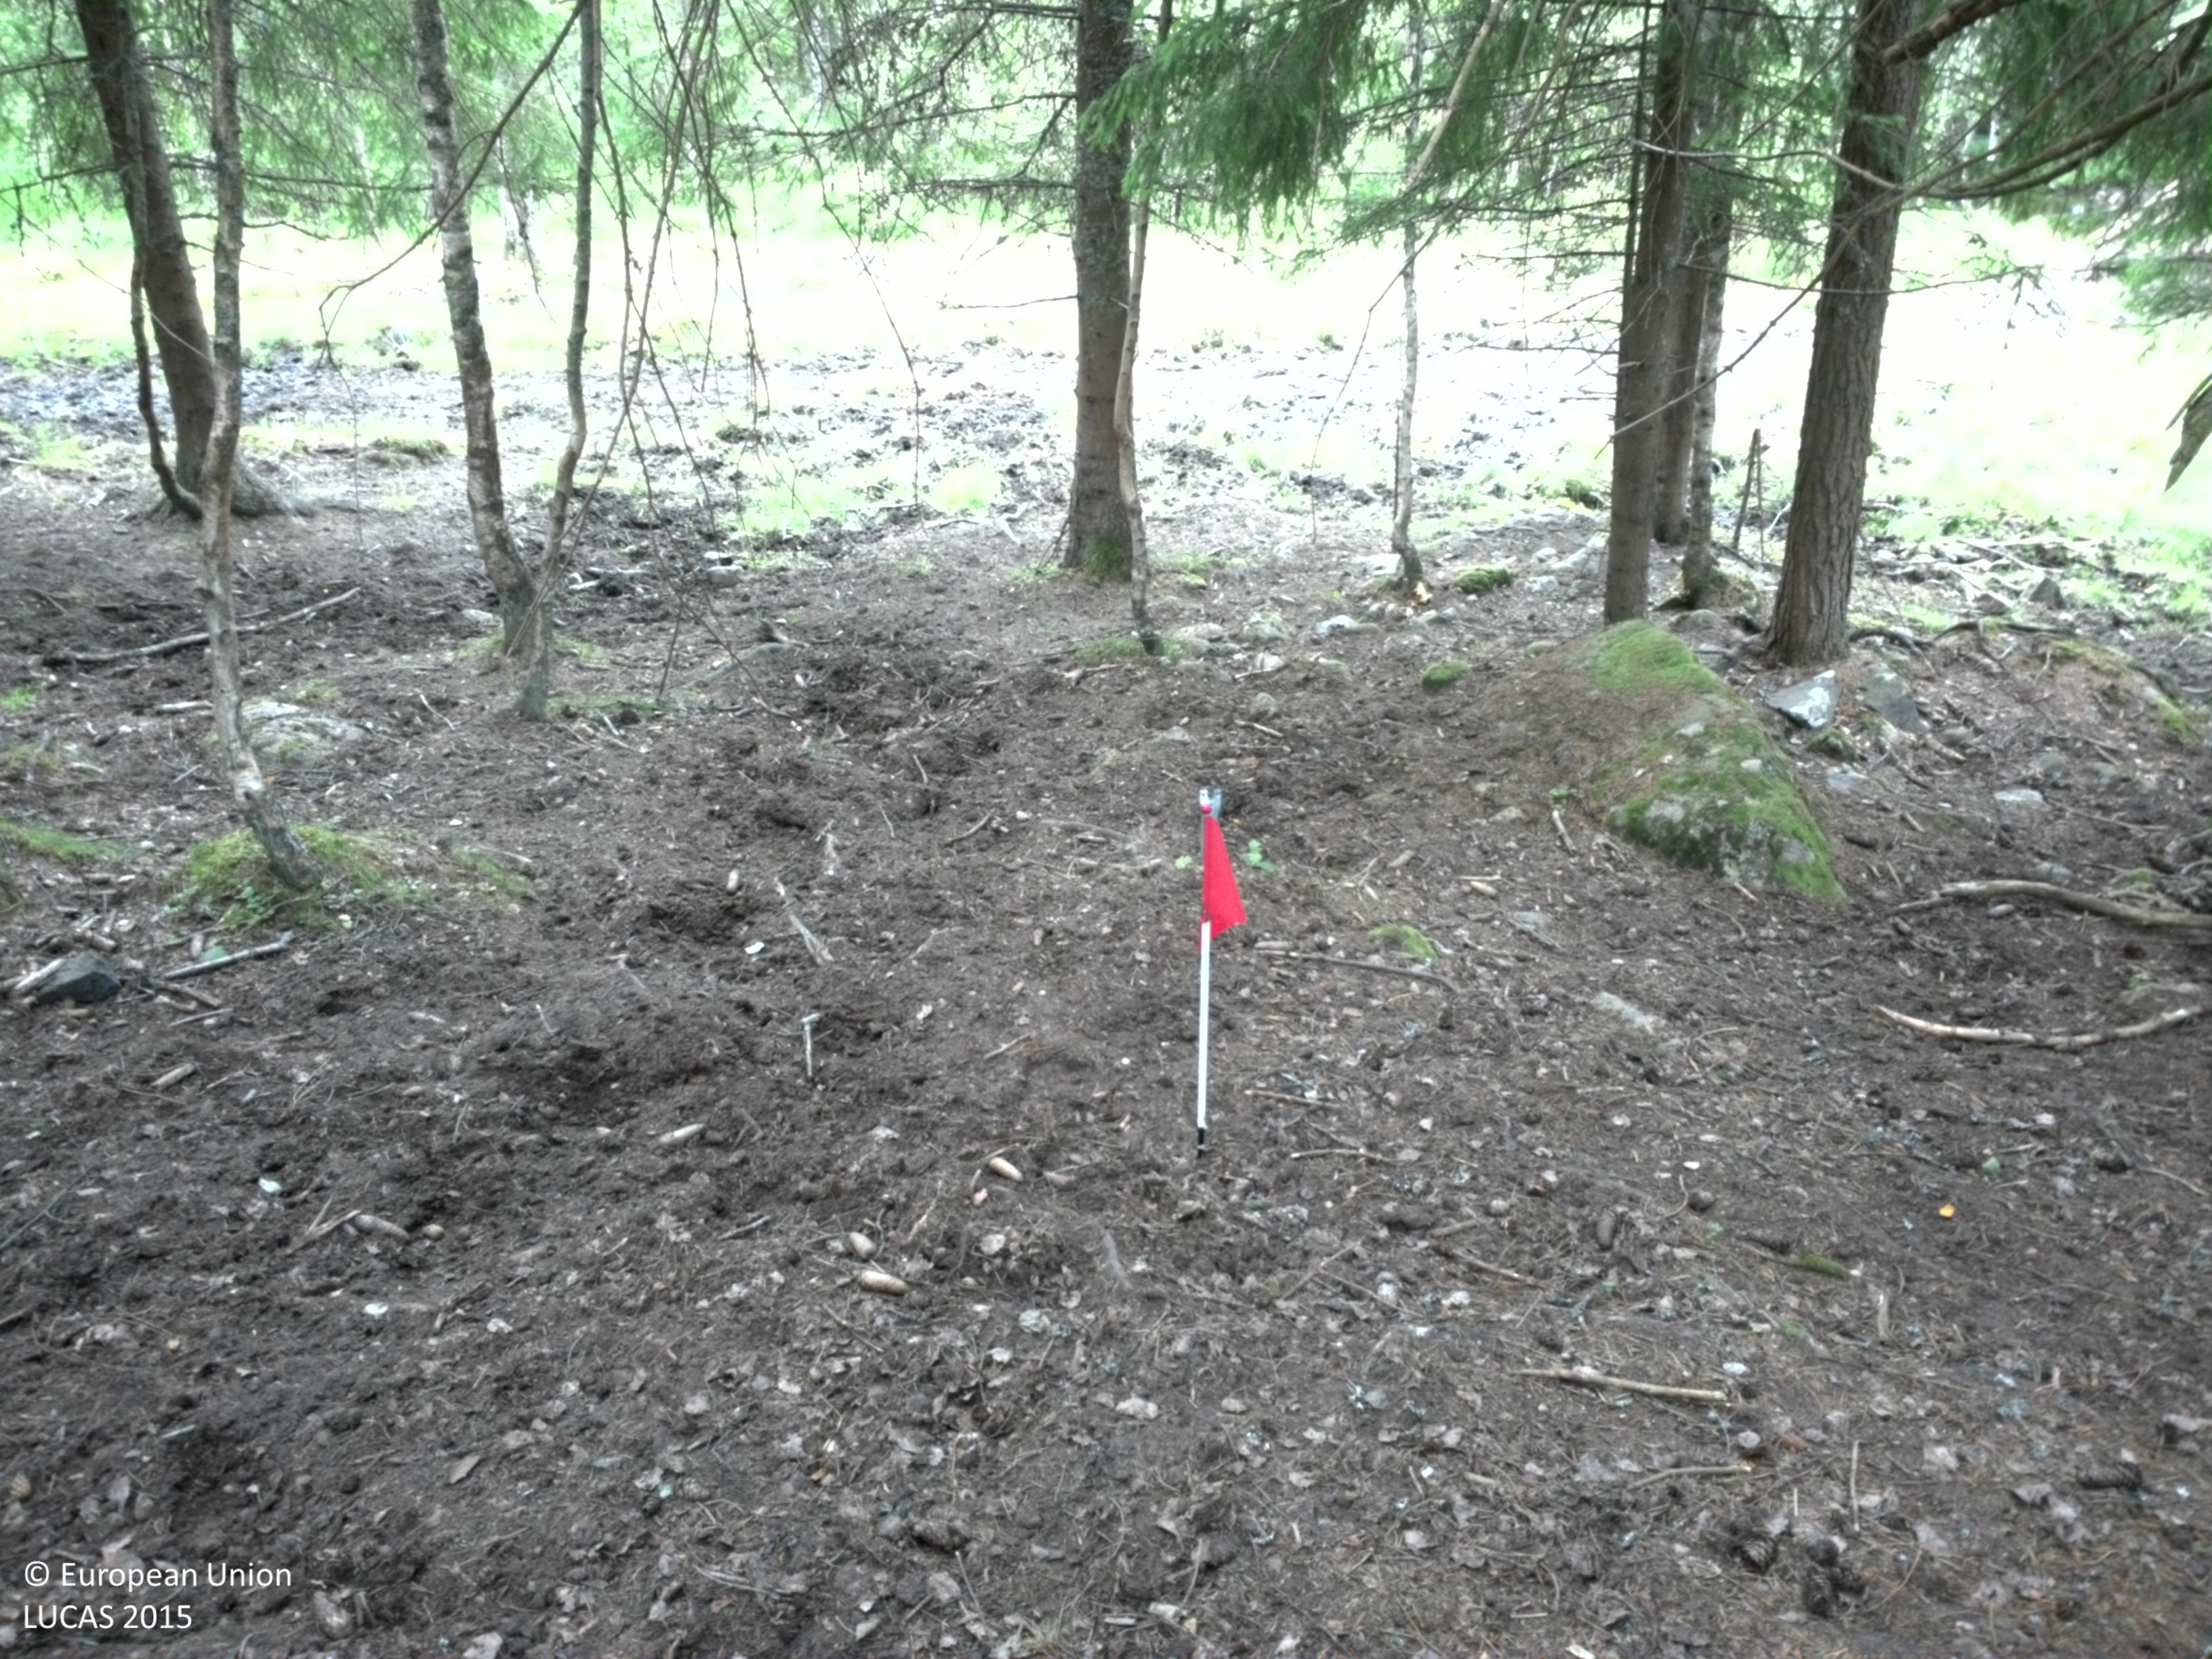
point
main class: Woodland
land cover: Spruce dominated coniferous woodland
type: boreal forest
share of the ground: > 75 %
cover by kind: coniferous forest trees 80 %, broadleaved forest trees 10 %, lichens and mosses 10 %
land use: Forestry
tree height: > 5 m
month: July
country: SE
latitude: 57.5419
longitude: 14.7236
